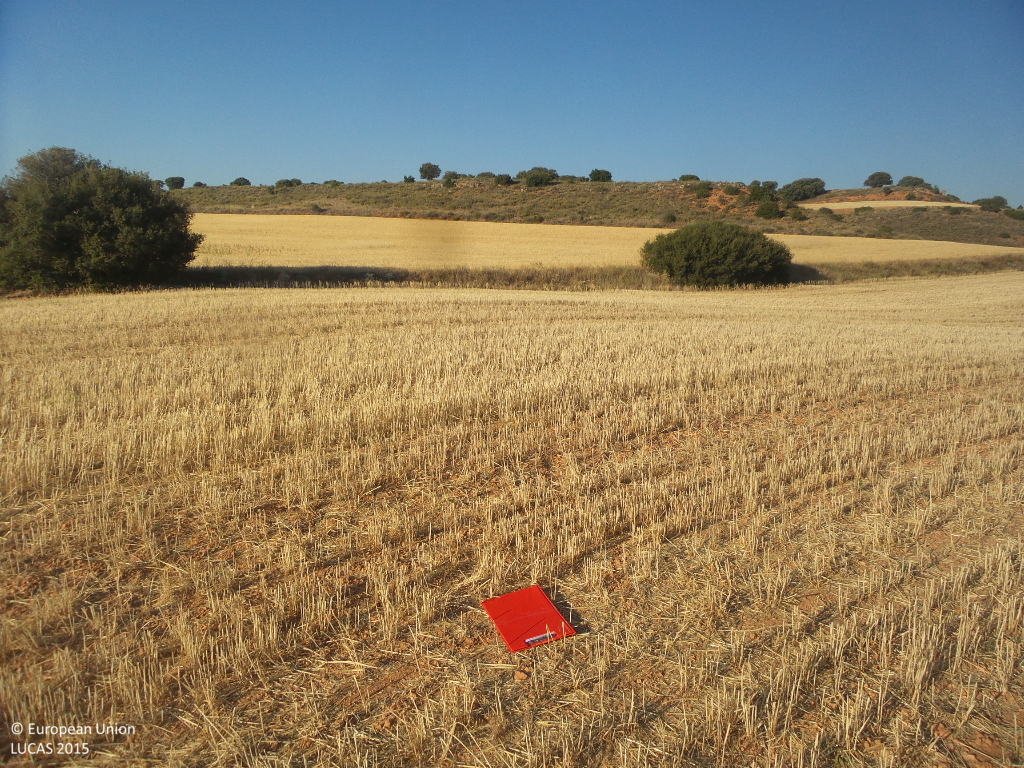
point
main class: Cropland
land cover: Barley
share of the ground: < 10 %
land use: Agriculture (excluding fallow land and kitchen gardens)
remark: Harvested field
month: July
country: ES
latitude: 41.2721
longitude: -2.0737
